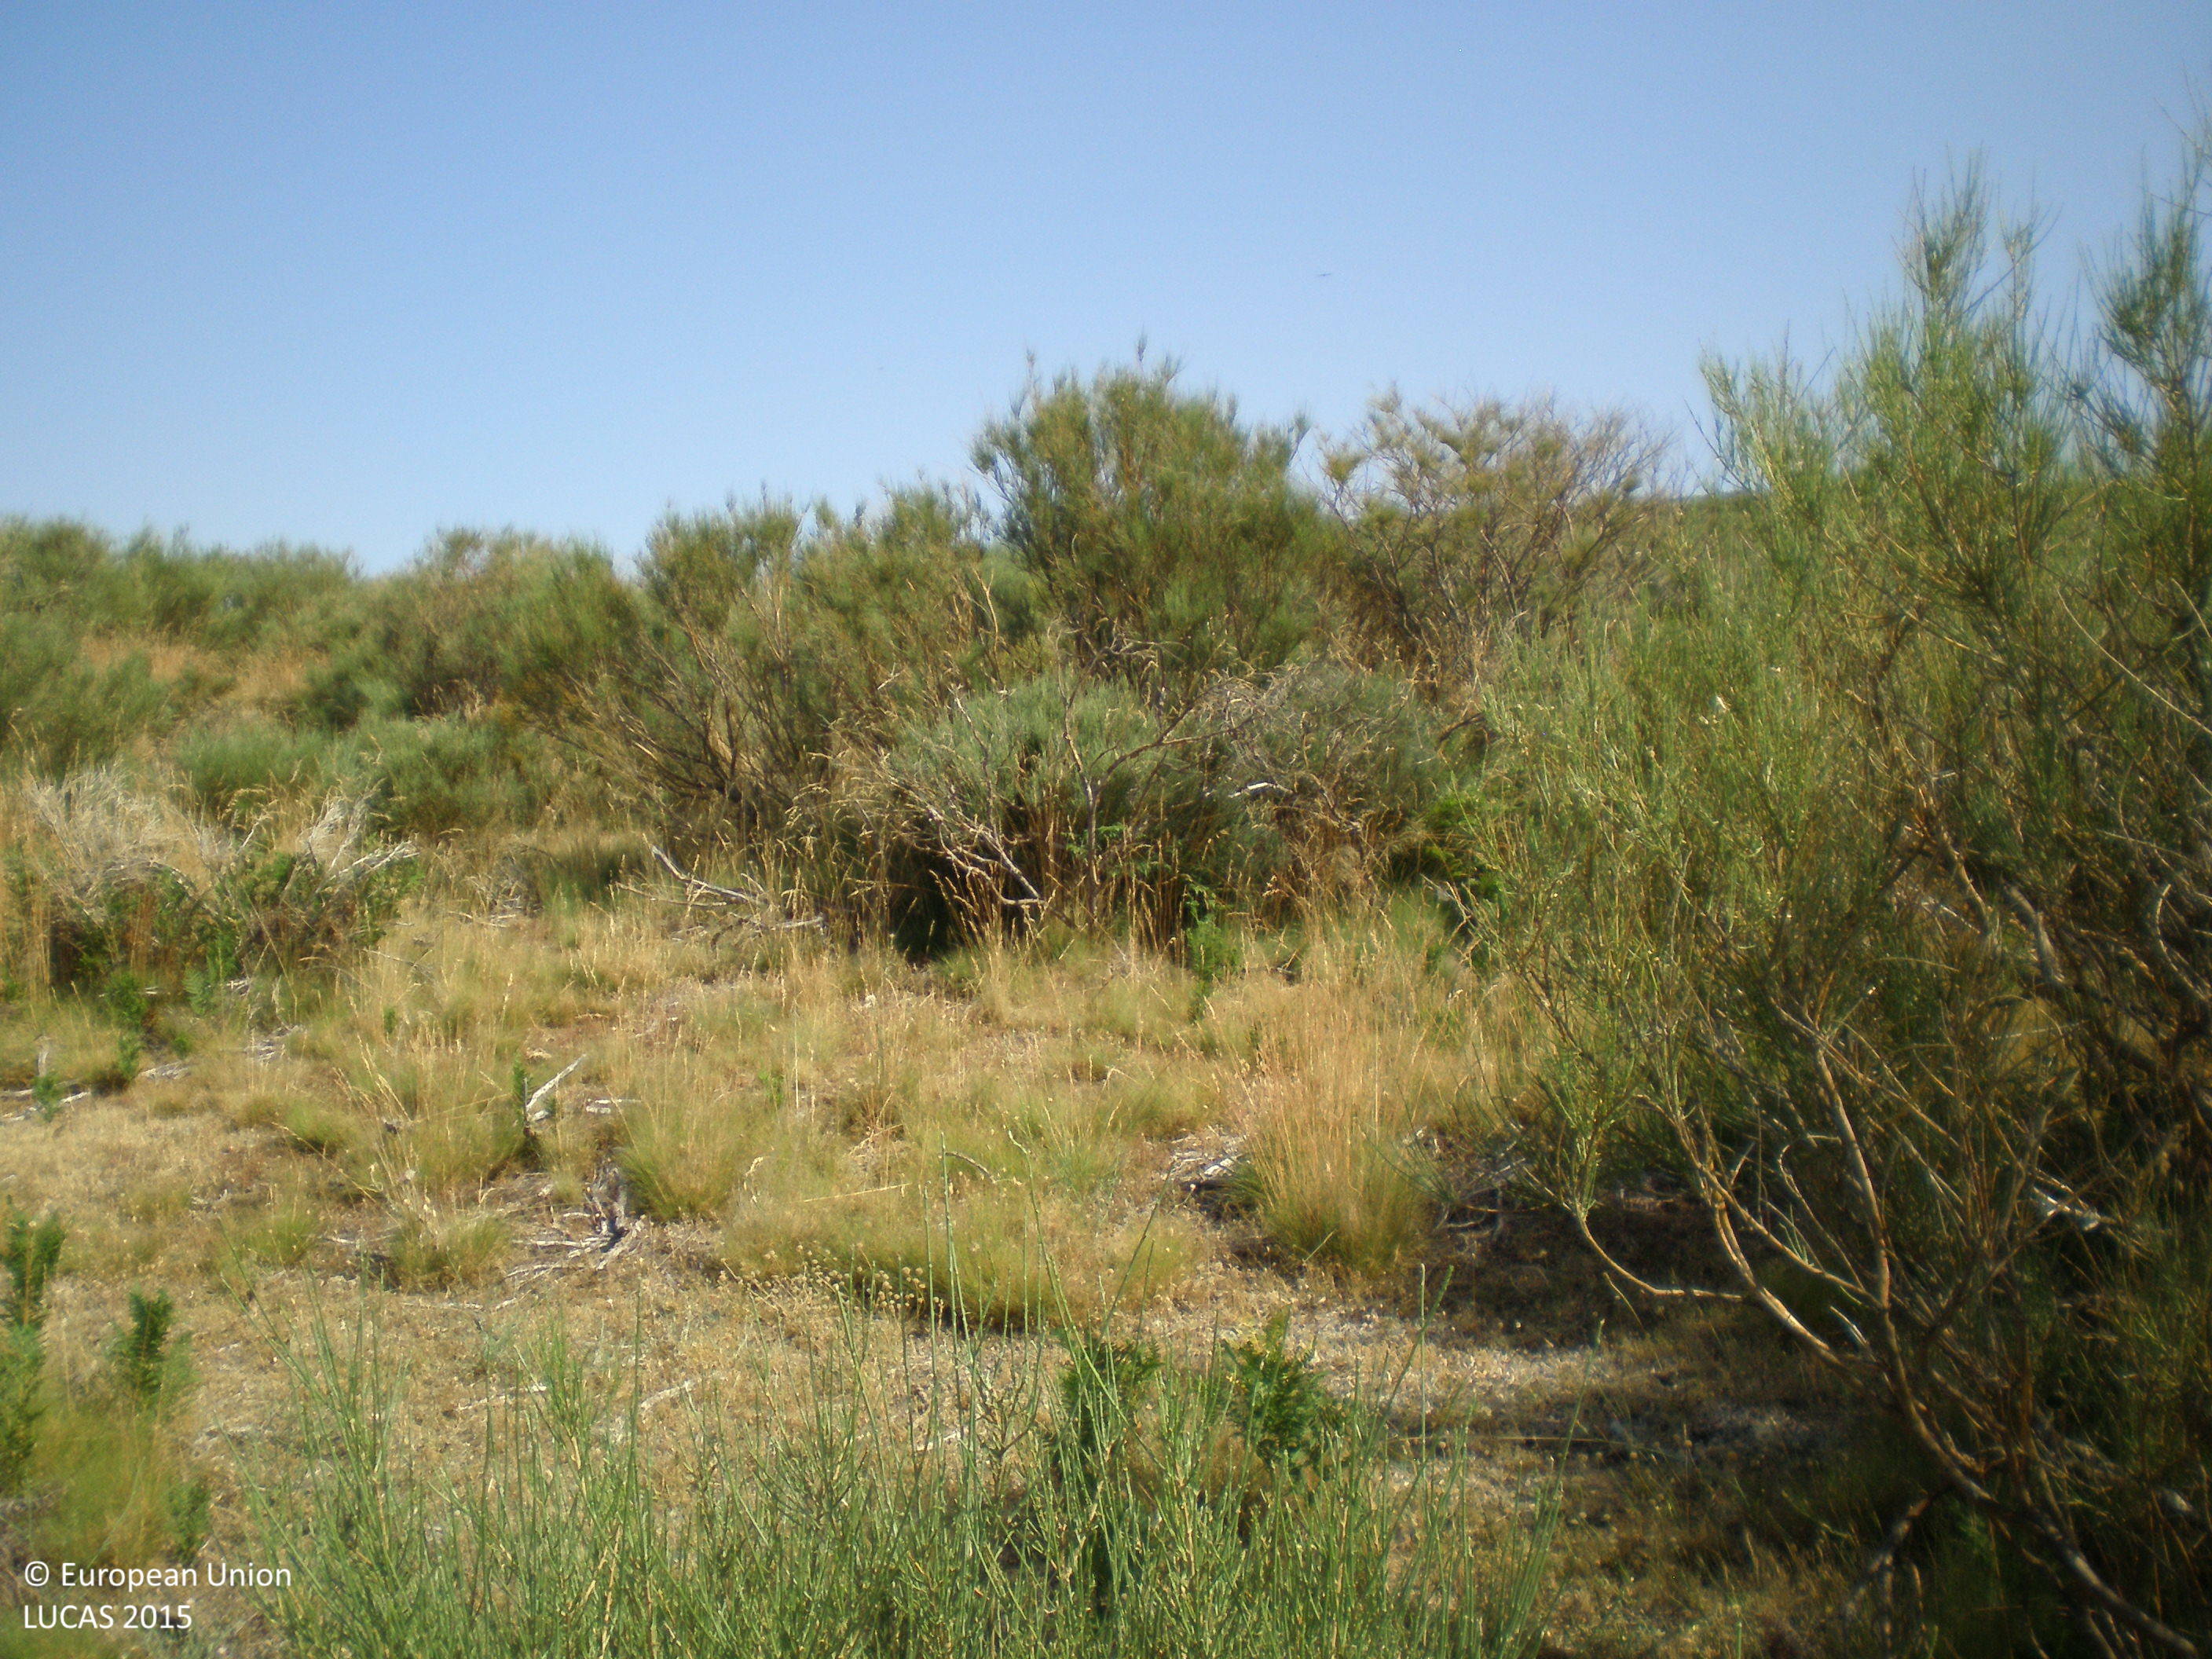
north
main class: Shrubland
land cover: Shrubland without tree cover
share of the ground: 50 - 75 %
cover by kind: shrubs 70 %, herbaceous plants 30 %
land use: Semi-natural and natural areas not in use
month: July
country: ES
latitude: 40.3624
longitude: -5.1916
